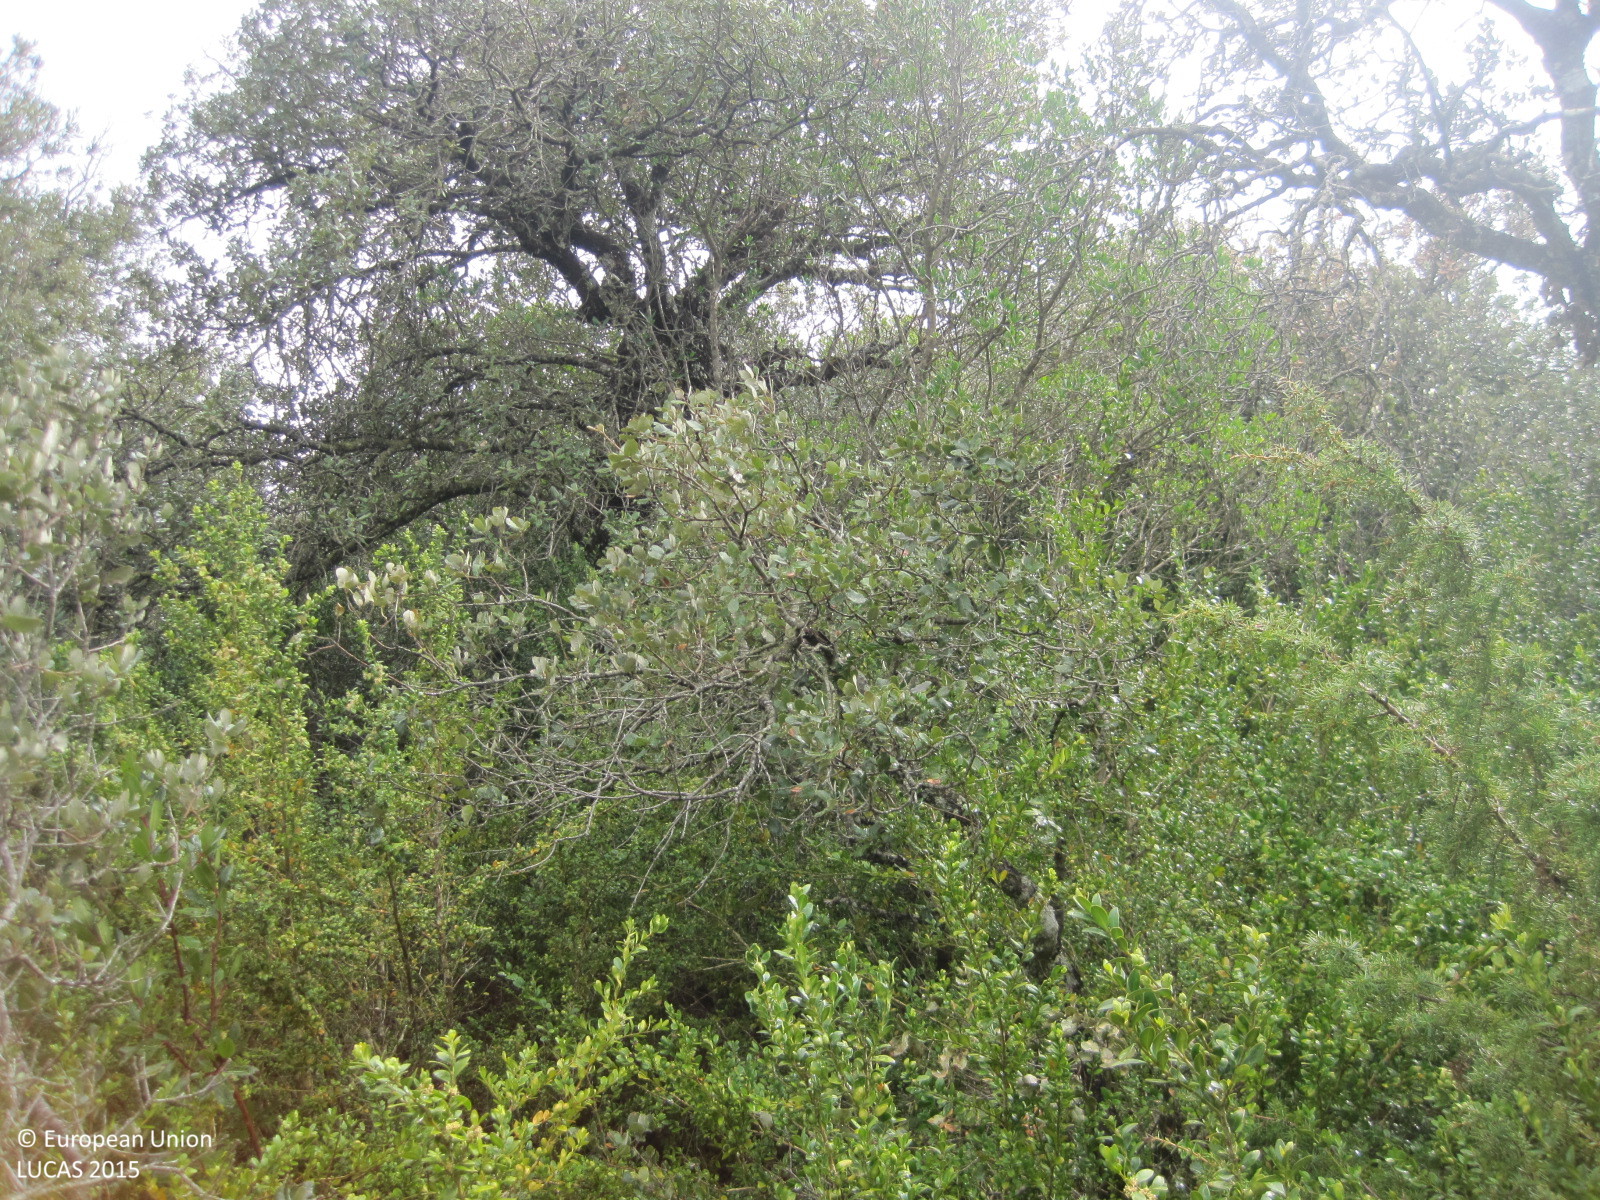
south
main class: Woodland
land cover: Broadleaved woodland
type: broadleaved evergreen forest
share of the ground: > 75 %
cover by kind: broadleaved forest trees 100 %
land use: Semi-natural and natural areas not in use
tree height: > 5 m
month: April
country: ES
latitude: 42.6842
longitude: -2.1625
